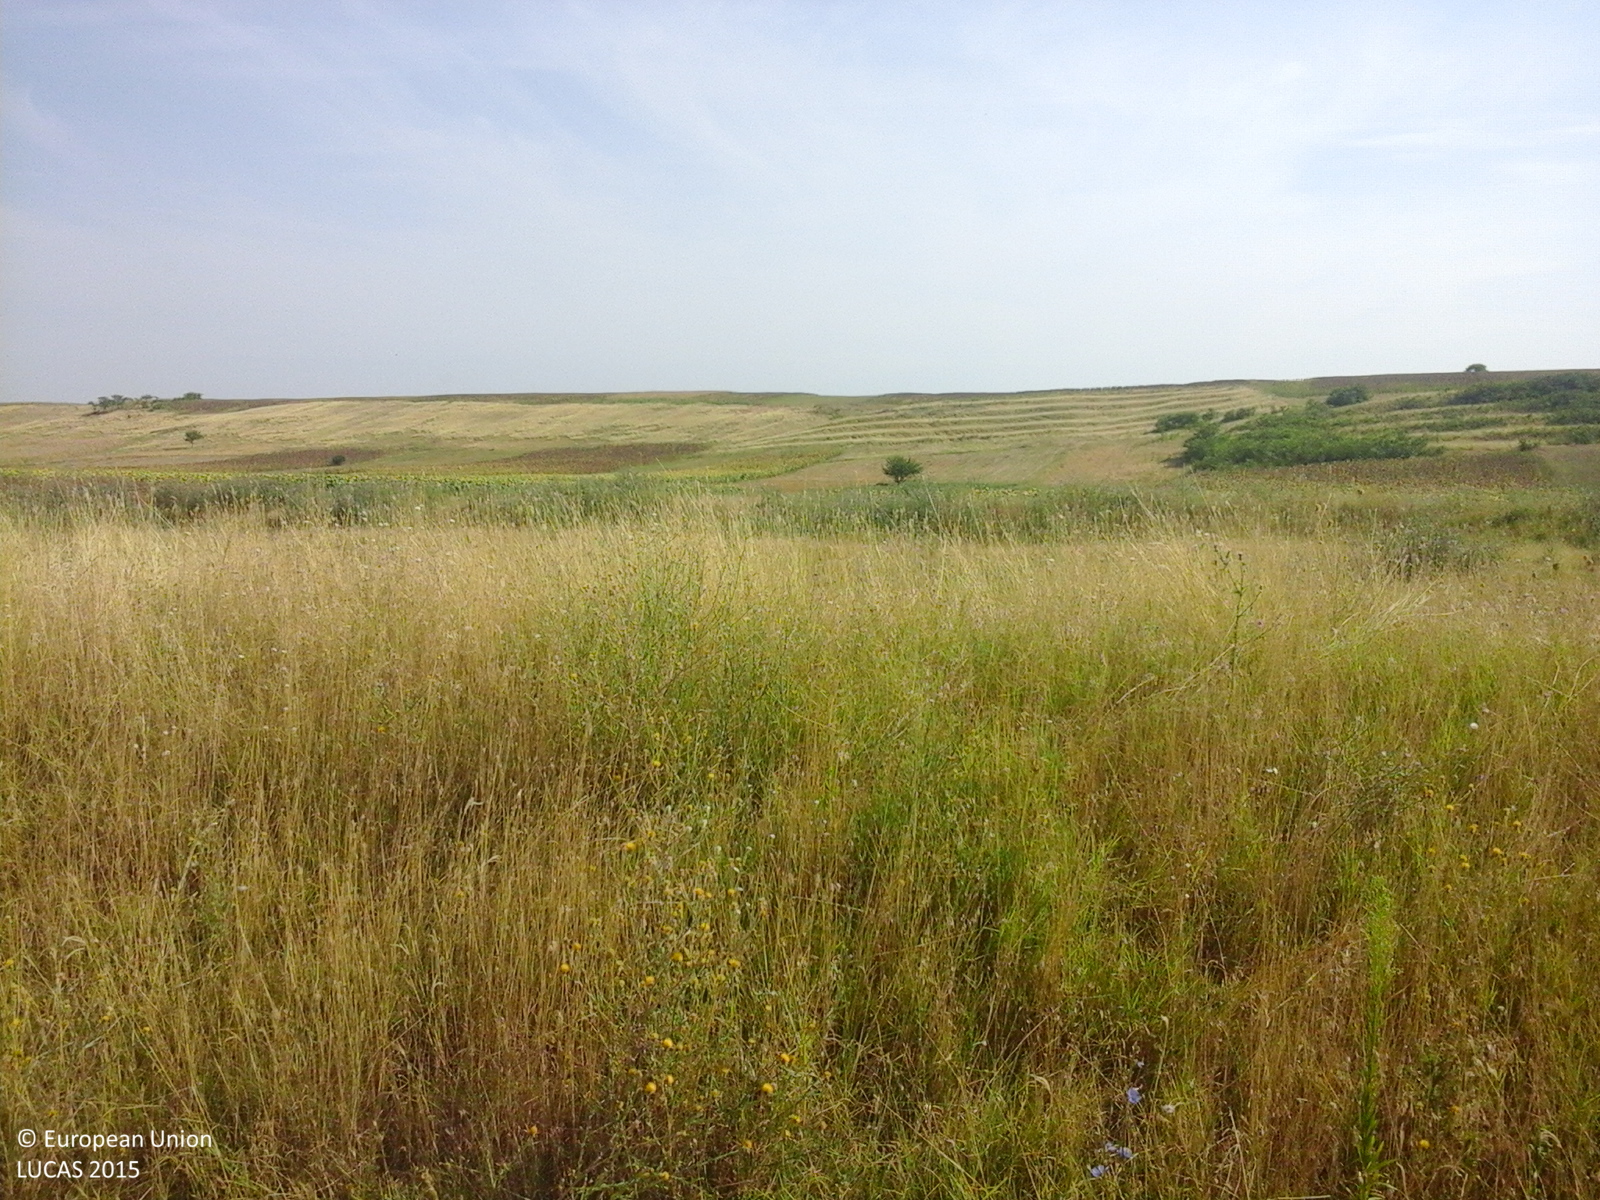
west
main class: Cropland
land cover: Sunflower
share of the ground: > 75 %
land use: Agriculture (excluding fallow land and kitchen gardens)
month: August
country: RO
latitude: 44.1314
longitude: 23.2827
